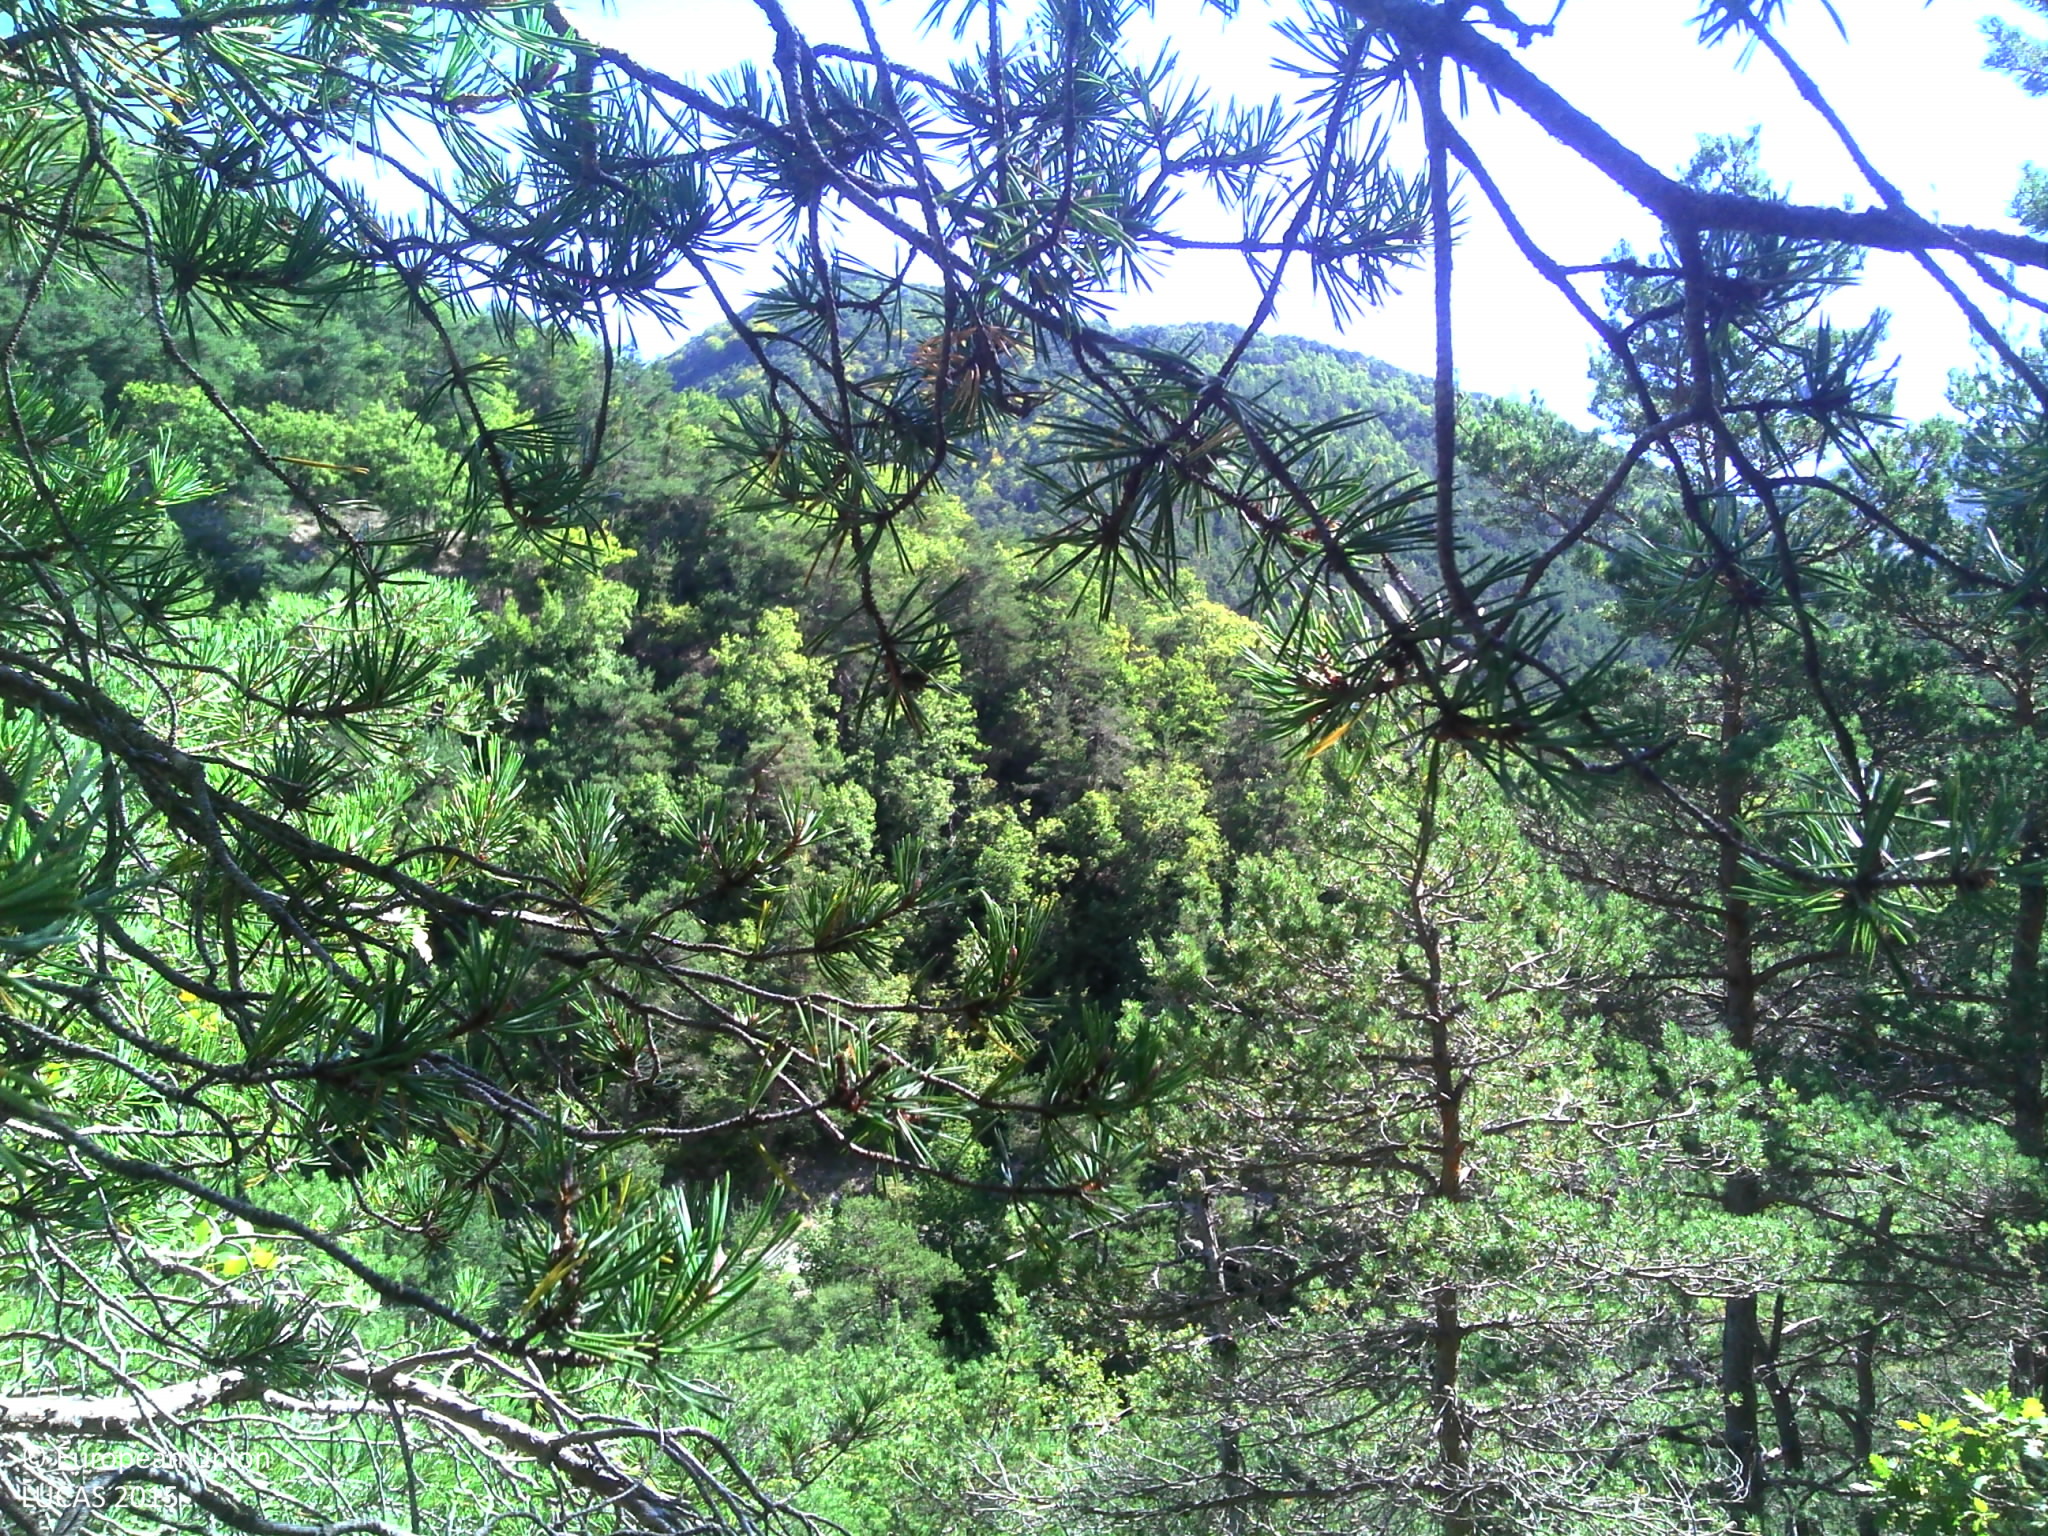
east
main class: Woodland
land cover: Pine dominated coniferous woodland
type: coniferous forest of the mediterranean region
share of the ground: > 75 %
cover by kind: coniferous forest trees 95 %, broadleaved forest trees 5 %
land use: Semi-natural and natural areas not in use
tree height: > 5 m
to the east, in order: Pine dominated coniferous woodland; Shrubland with sparse tree cover; Broadleaved woodland; Rivers and streams; Broadleaved woodland; Paved roads, cycling and walking lanes; Broadleaved woodland; Pine dominated coniferous woodland
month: September
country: FR
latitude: 44.3265
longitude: 5.5307
